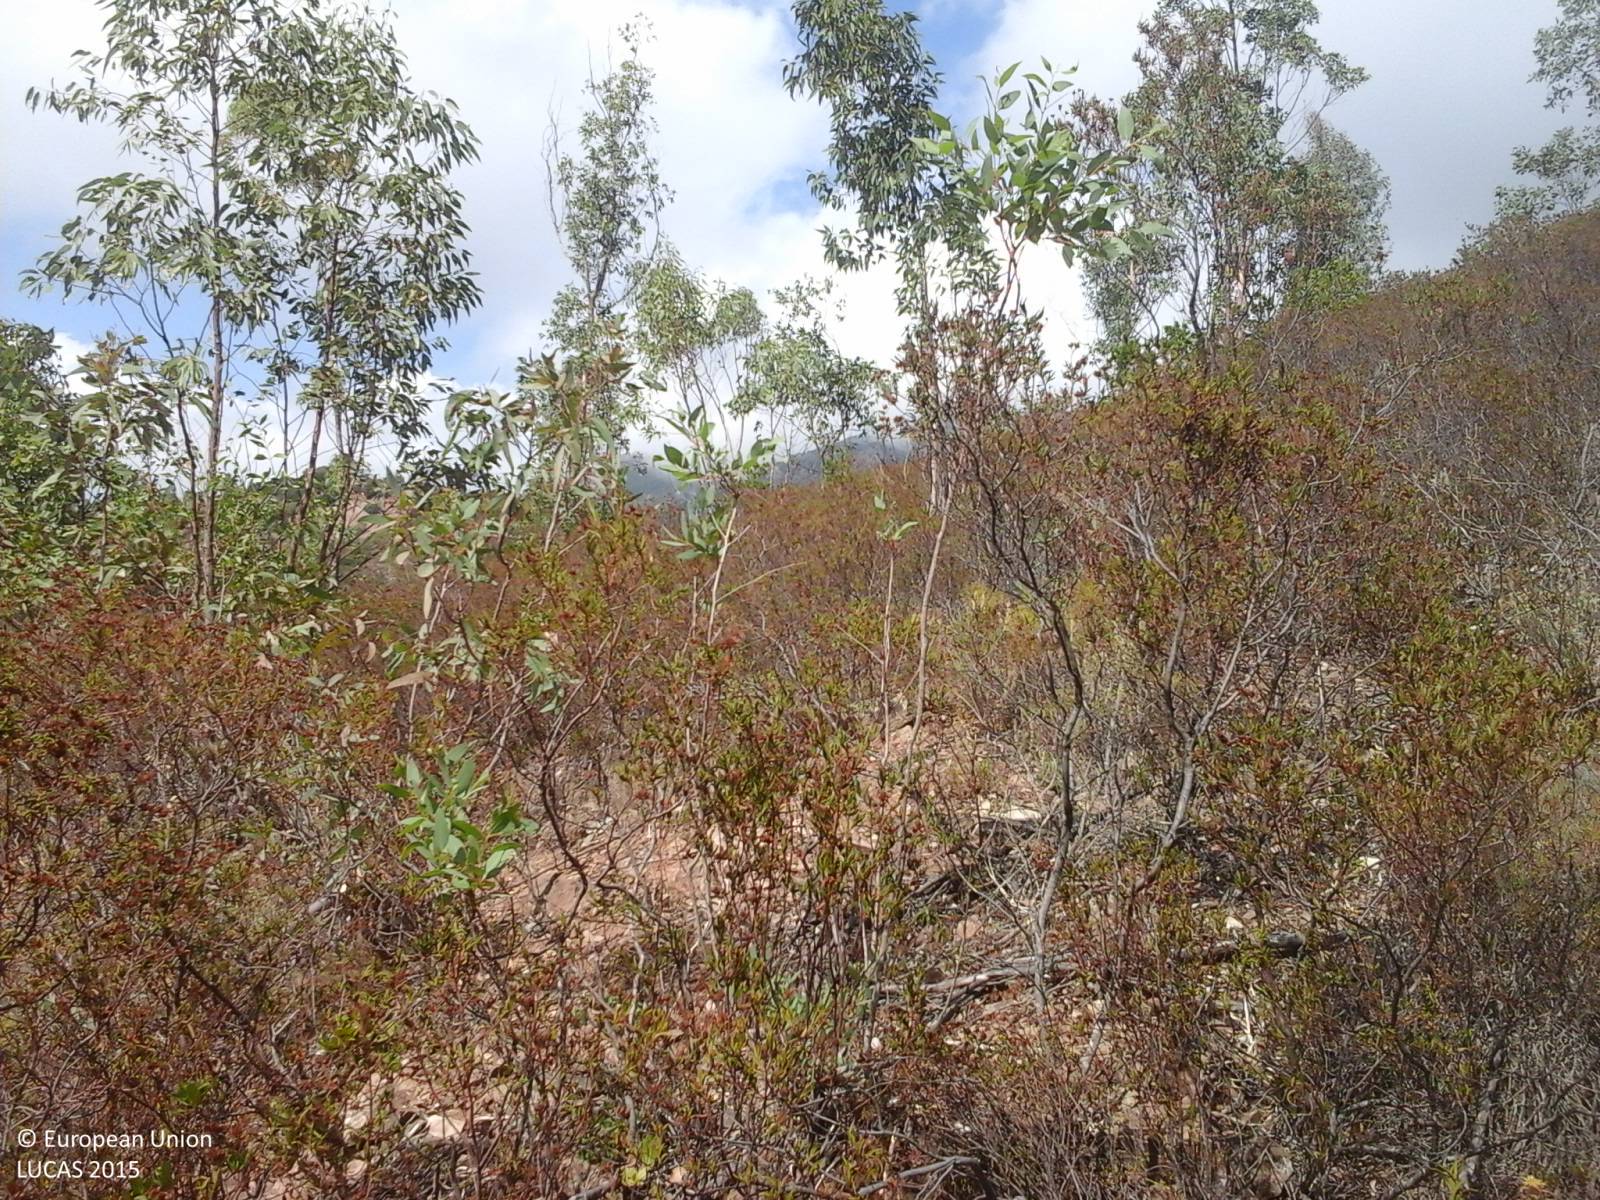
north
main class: Woodland
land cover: Broadleaved woodland
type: exotic forest
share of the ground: > 75 %
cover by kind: shrubs 70 %, broadleaved forest trees 30 %
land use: Forestry
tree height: < 5 m
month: August
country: IT
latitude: 39.7052
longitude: 9.6173
